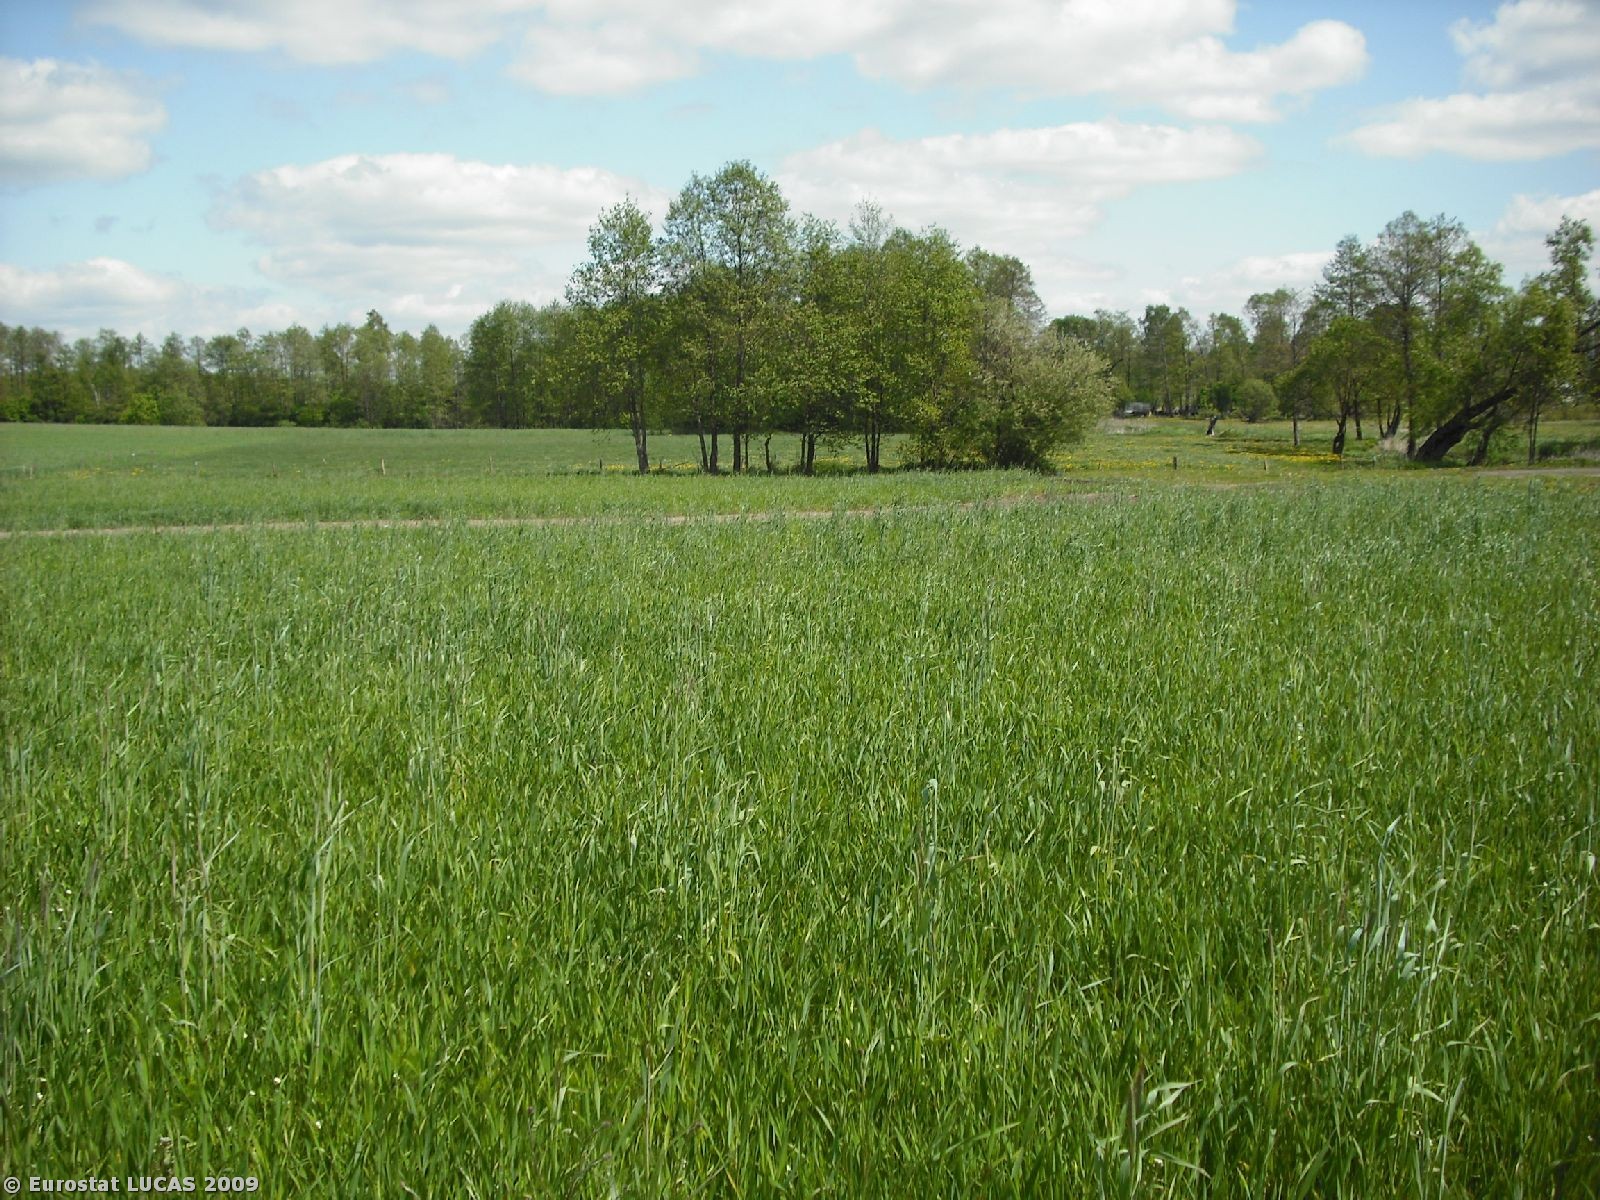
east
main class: Cropland
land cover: Triticale
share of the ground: > 75 %
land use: Agriculture (excluding fallow land and kitchen gardens)
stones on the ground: < 10 %
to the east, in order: Triticale; Grassland without tree/shrub cover; Tracks; Grass margins; Grassland without tree/shrub cover; Broadleaved woodland; Grassland without tree/shrub cover; Inland running water; Grassland without tree/shrub cover
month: May
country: PL
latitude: 52.9020
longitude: 22.4493
